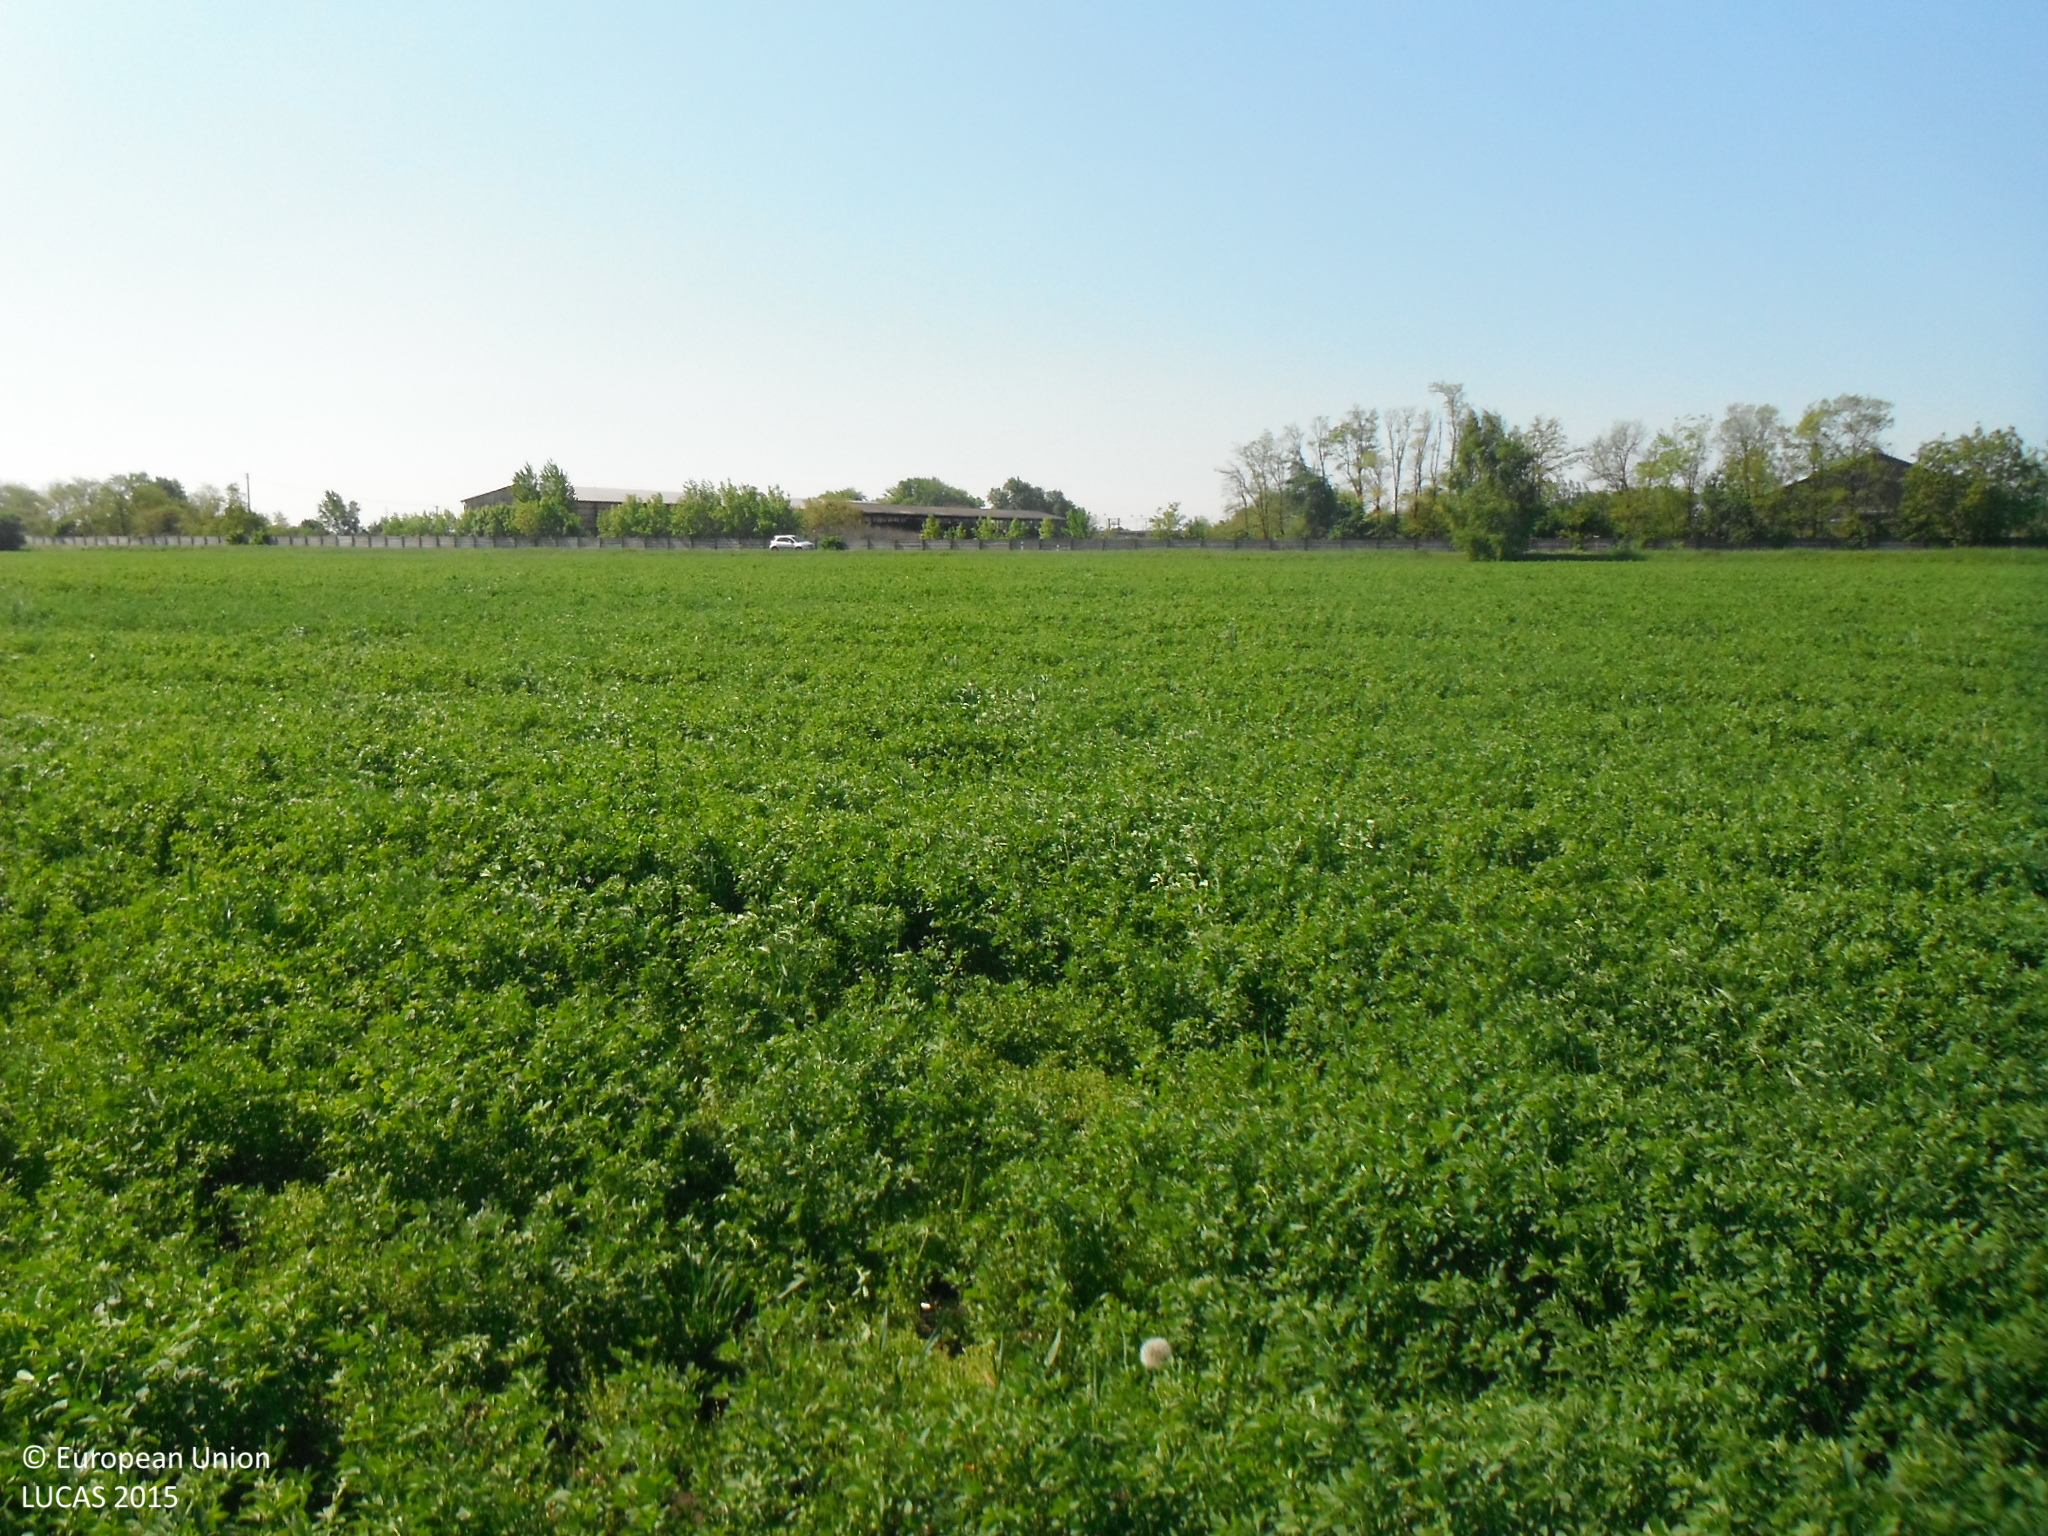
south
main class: Cropland
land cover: Lucerne
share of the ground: > 75 %
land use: Agriculture (excluding fallow land and kitchen gardens)
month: May
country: SK
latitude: 47.9108
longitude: 17.5422
